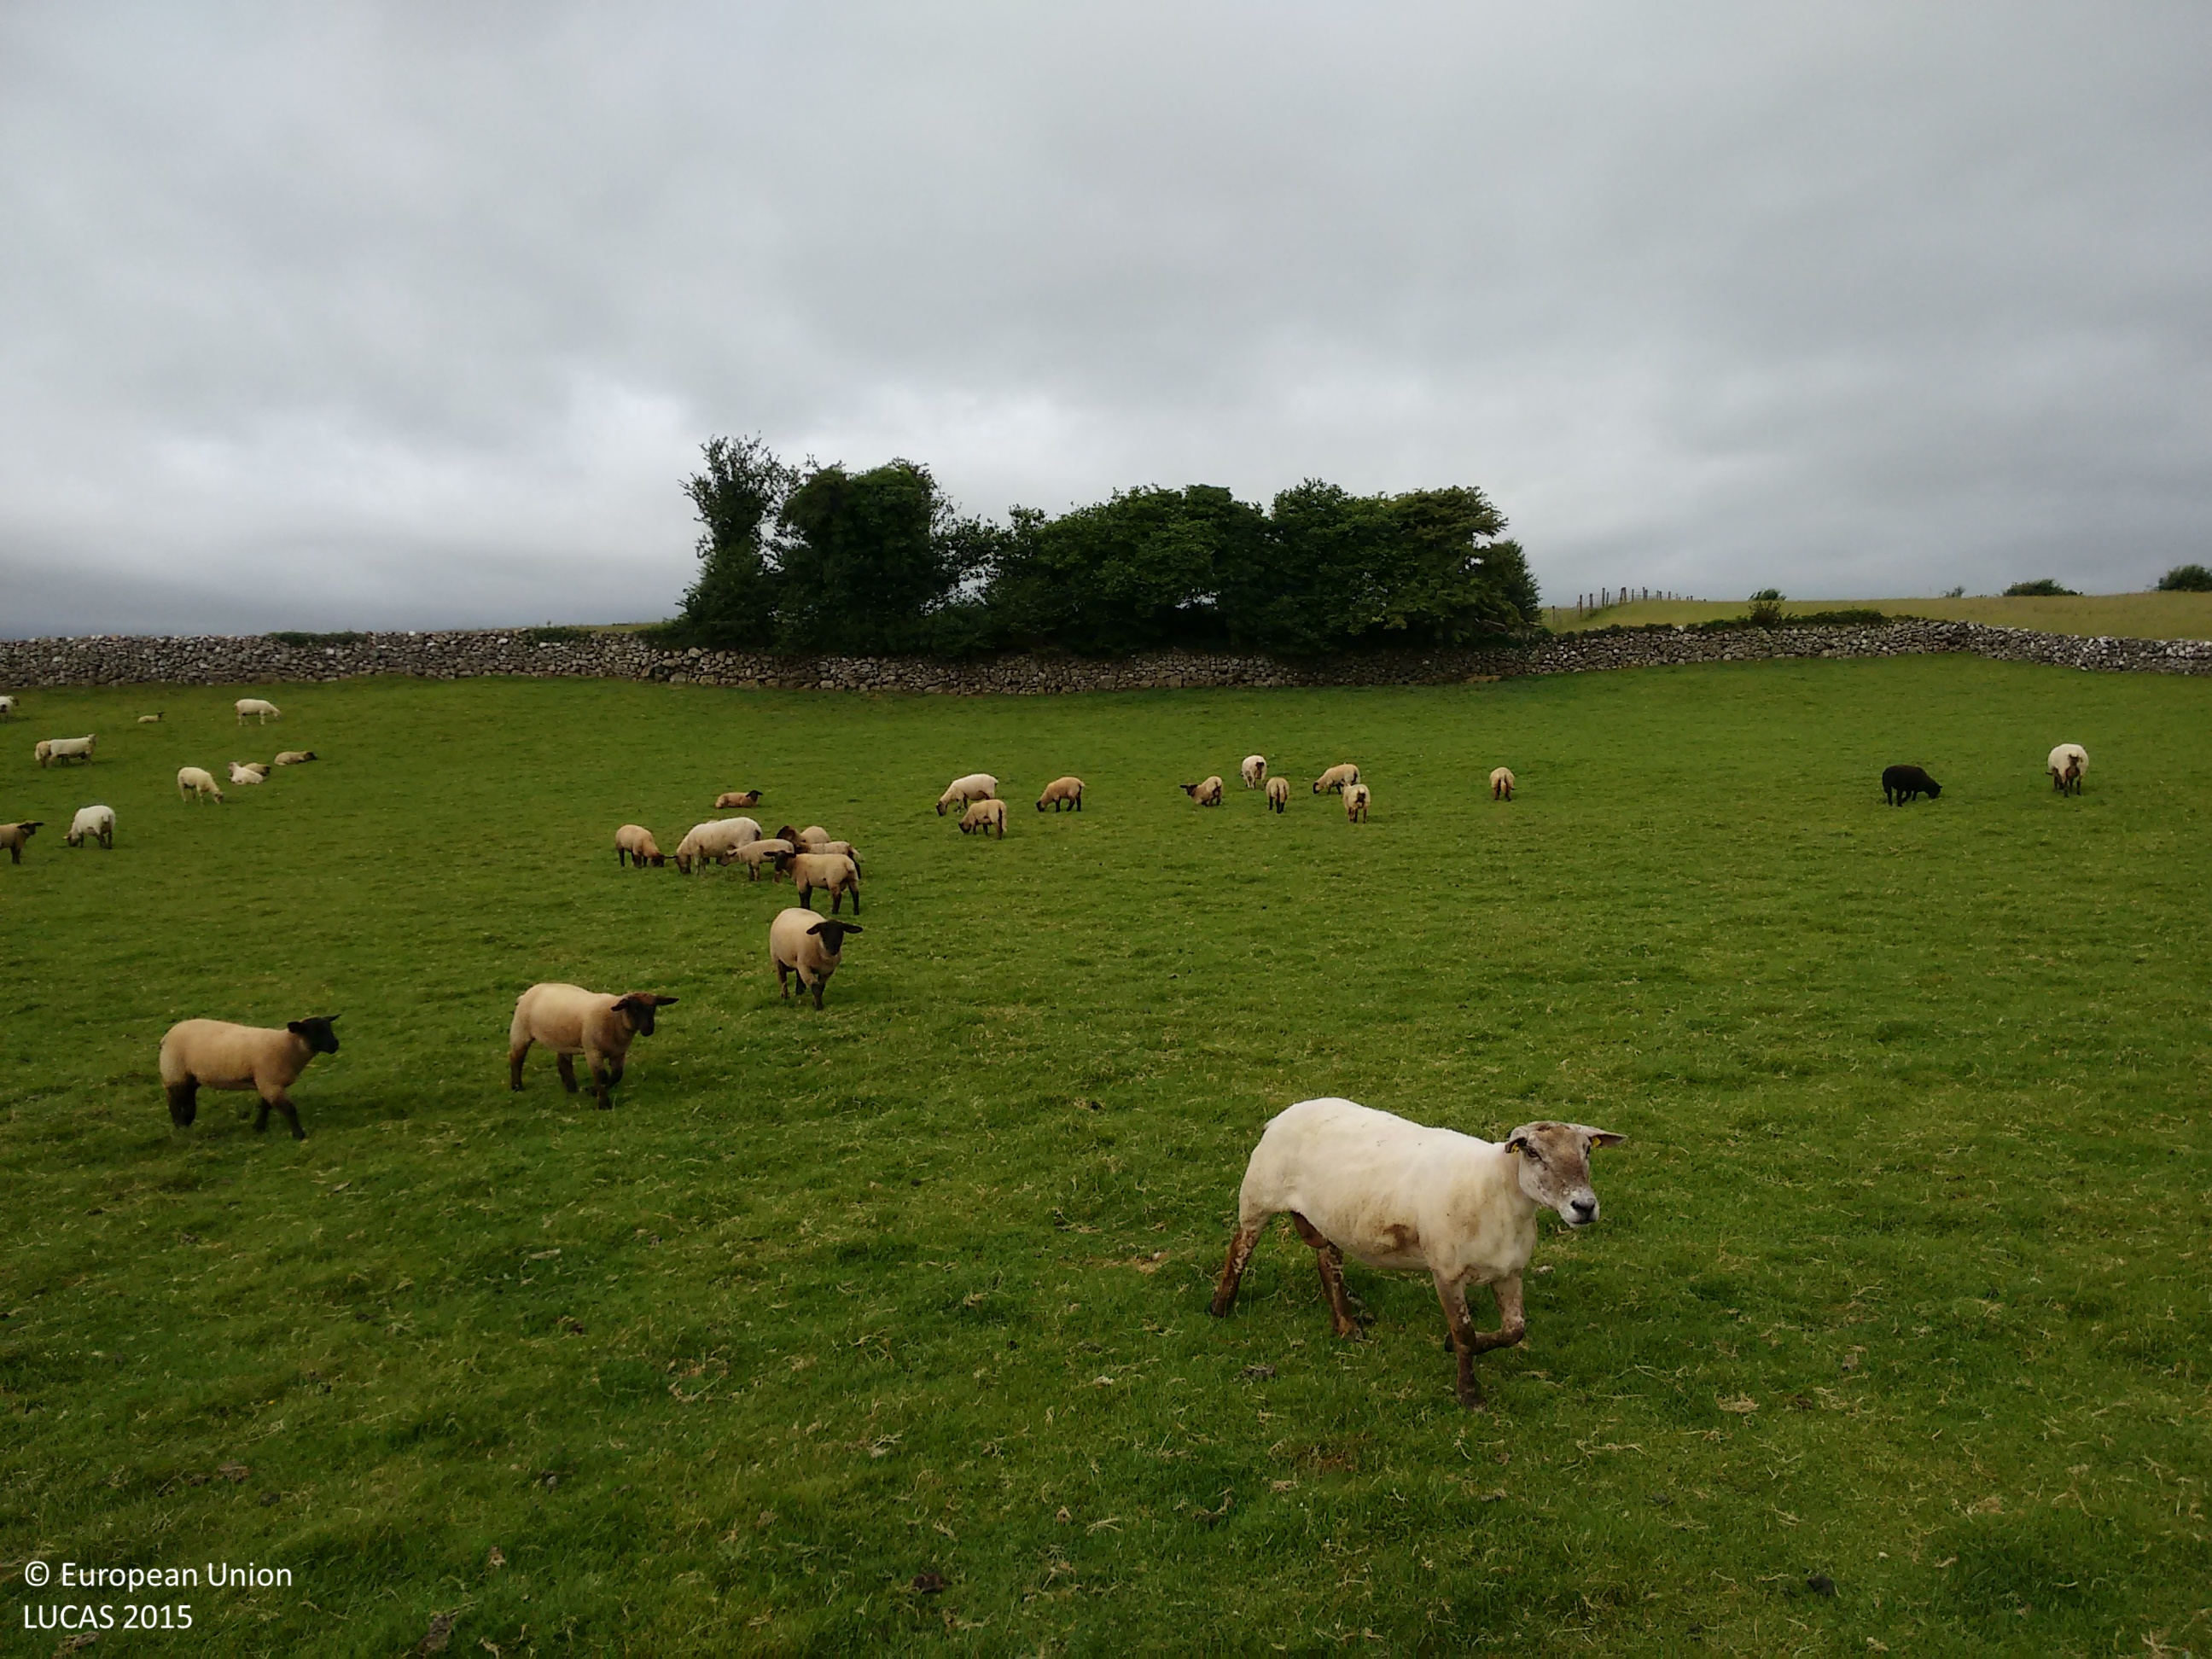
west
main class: Grassland
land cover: Grassland without tree/shrub cover
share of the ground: > 75 %
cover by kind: herbaceous plants 100 %
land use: Agriculture (excluding fallow land and kitchen gardens)
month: June
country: IE
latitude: 53.4715
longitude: -8.0286
